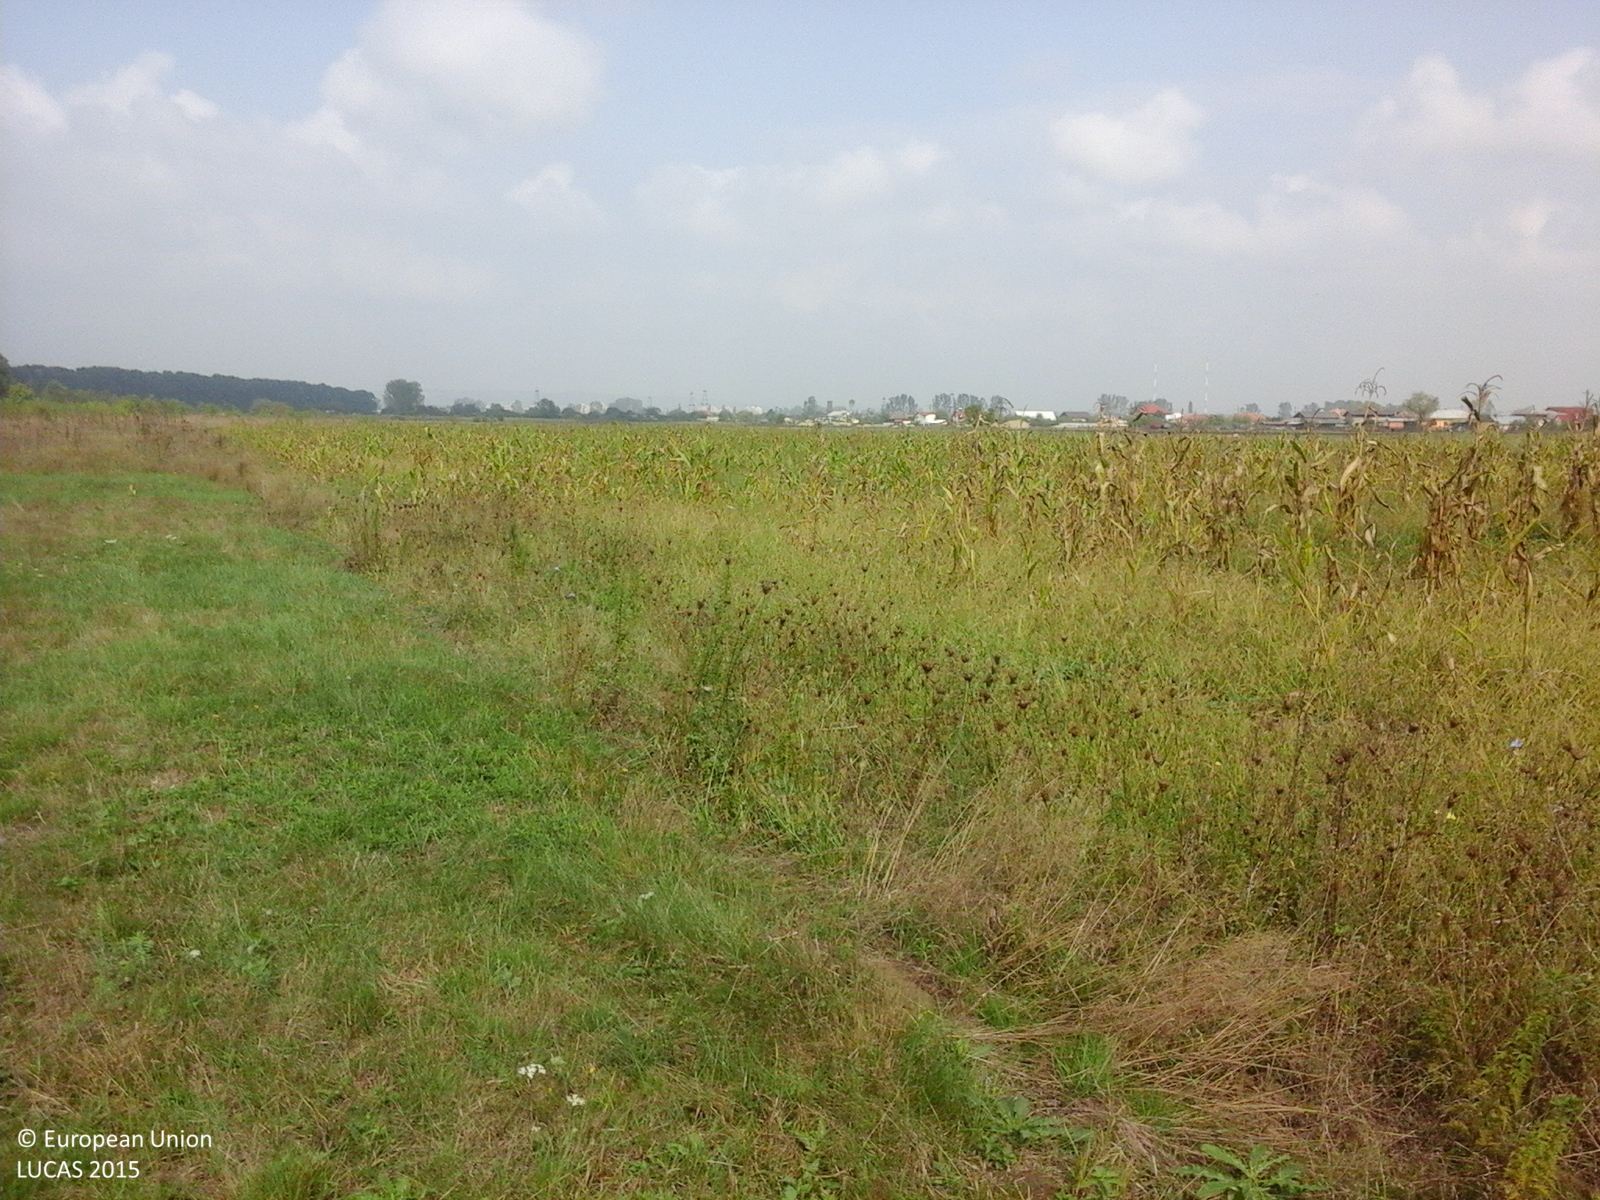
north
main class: Grassland
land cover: Grassland without tree/shrub cover
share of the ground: > 75 %
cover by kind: herbaceous plants 100 %
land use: Agriculture (excluding fallow land and kitchen gardens)
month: September
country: RO
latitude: 44.9893
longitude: 23.2826
